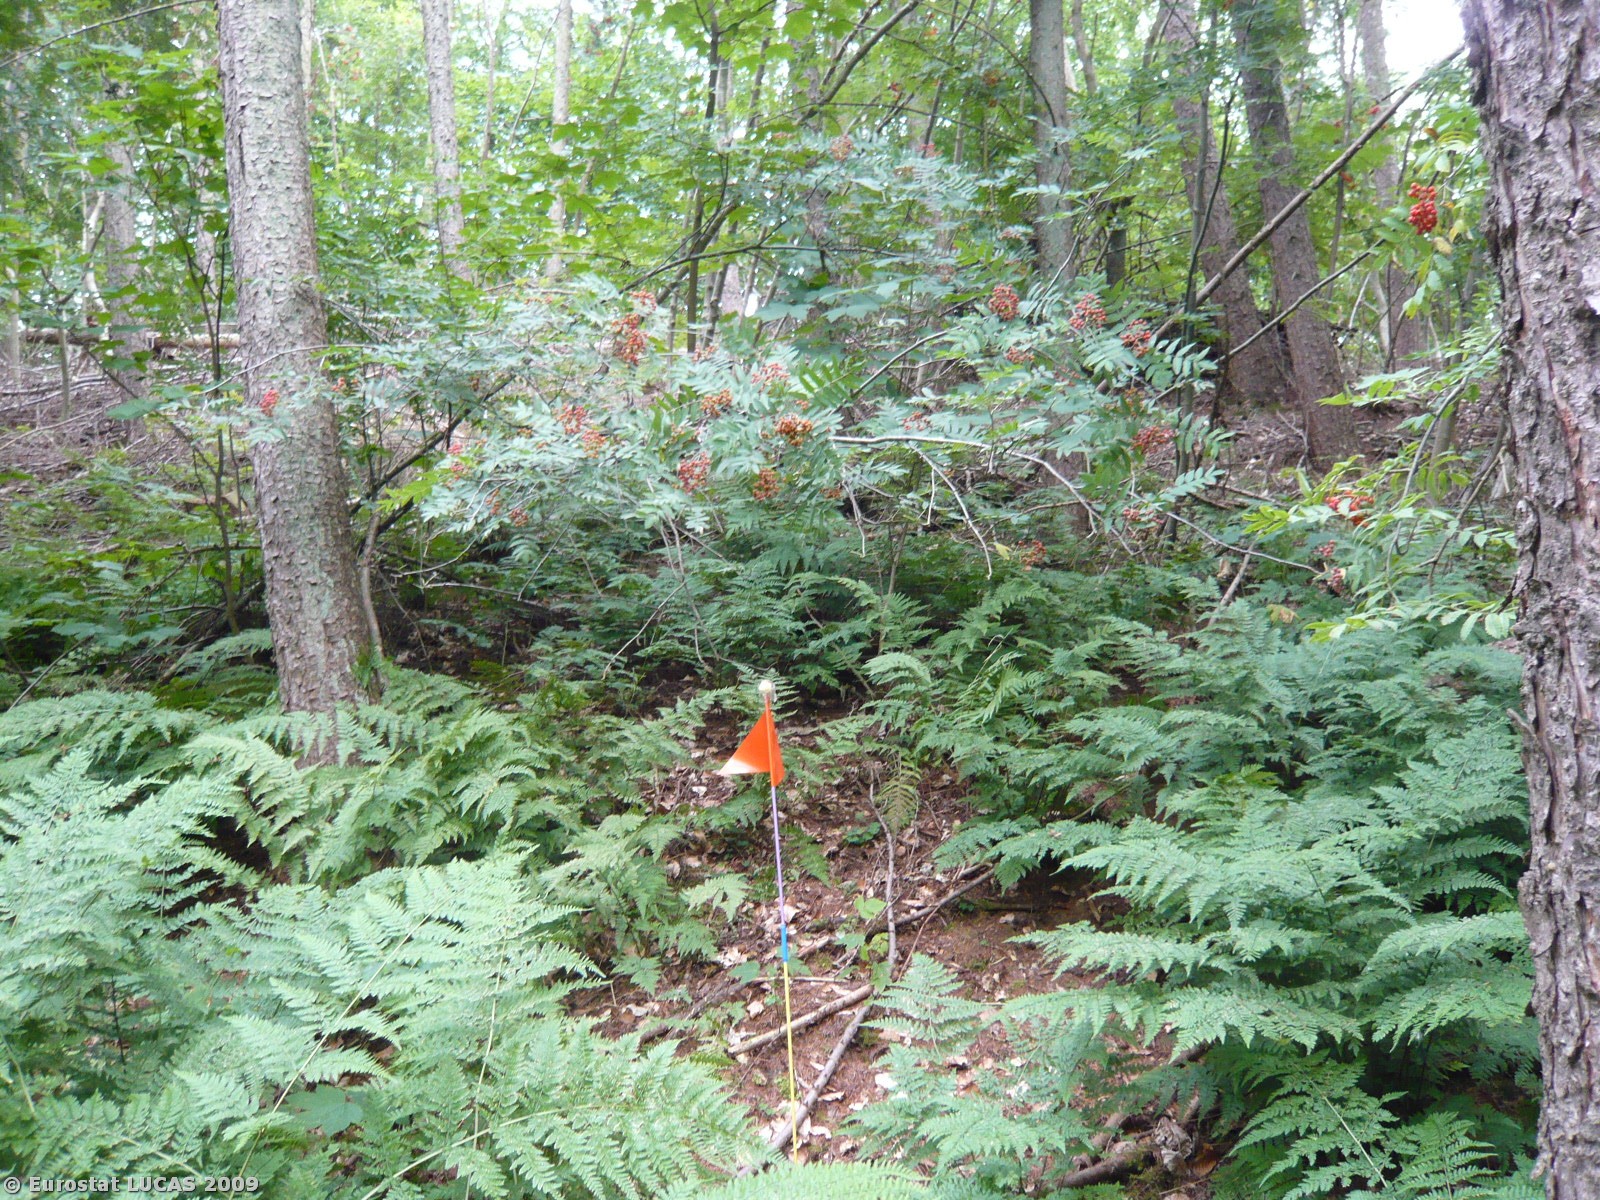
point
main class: Woodland
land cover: Coniferous woodland
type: hemiboreal forest and nemoral coniferous forest and mixed broadleaved-coniferous forest
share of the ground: > 75 %
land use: Amenities, museums, leisure
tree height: > 5 m
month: August
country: DK
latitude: 55.9739
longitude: 12.0331
